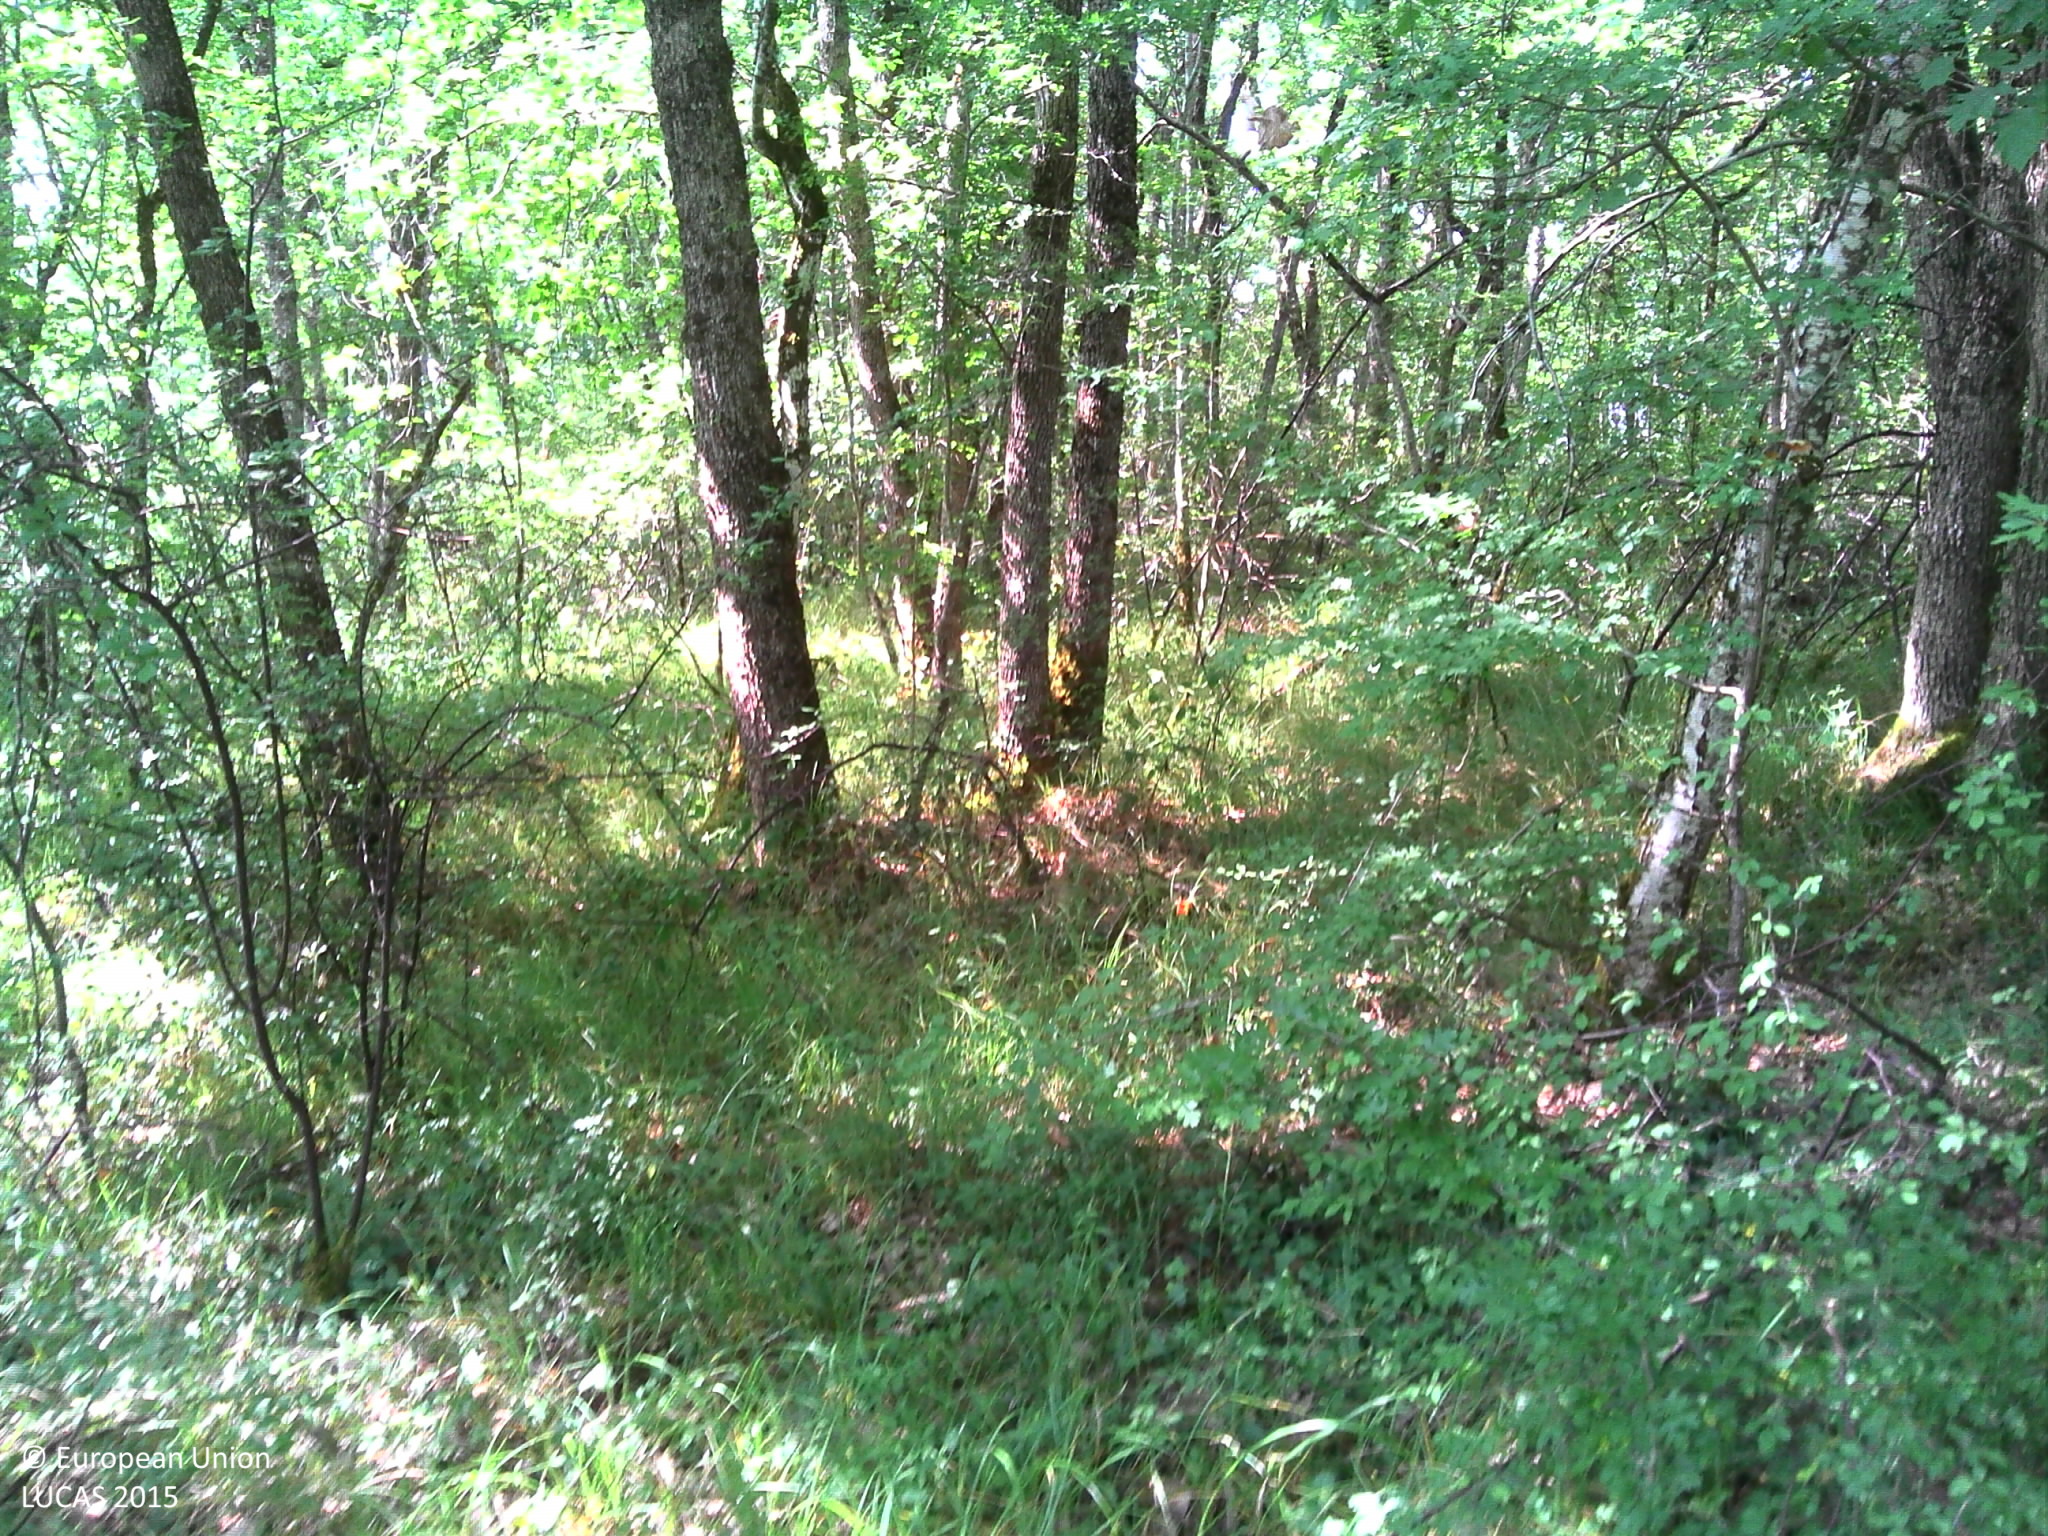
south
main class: Woodland
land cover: Broadleaved woodland
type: thermophilous deciduous forest
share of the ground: > 75 %
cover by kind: broadleaved forest trees 95 %, coniferous forest trees 5 %
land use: Forestry
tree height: > 5 m
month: July
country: FR
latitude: 44.5302
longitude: 0.8968
